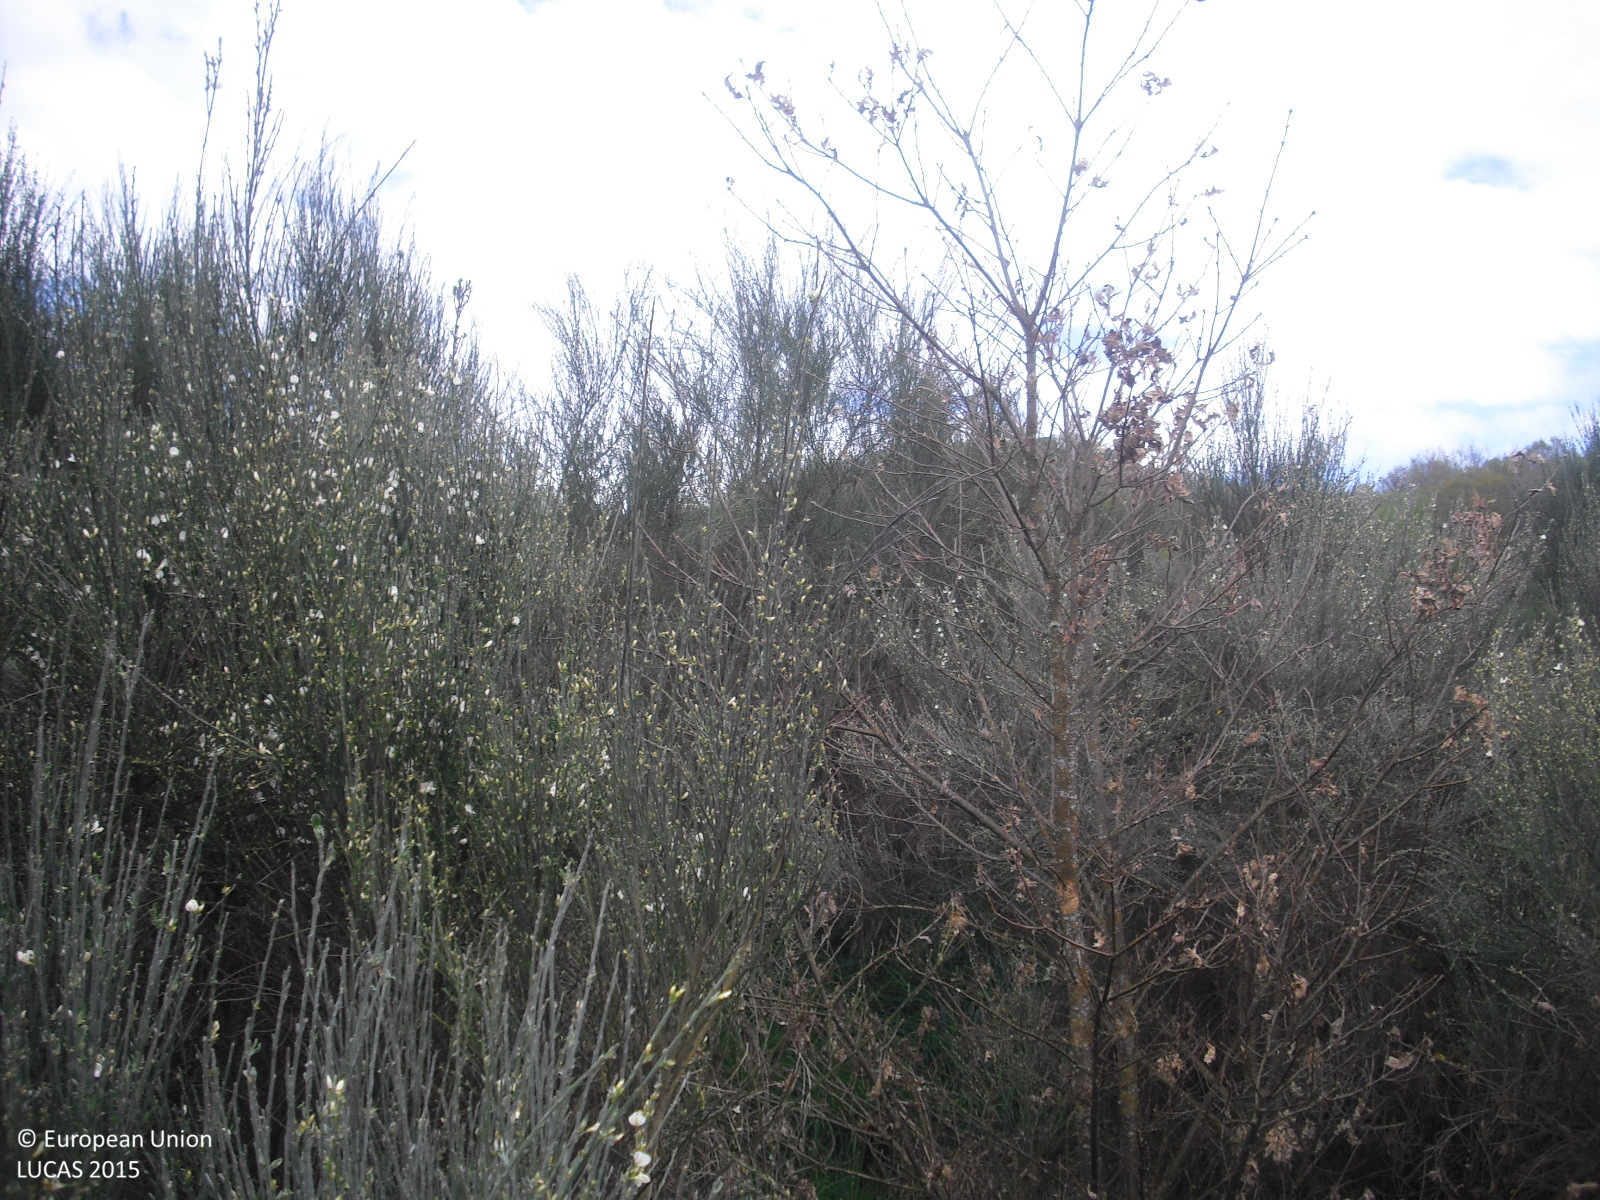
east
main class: Shrubland
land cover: Shrubland with sparse tree cover
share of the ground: > 75 %
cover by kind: shrubs 85 %, herbaceous plants 10 %, broadleaved forest trees 5 %
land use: Abandoned areas
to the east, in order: Shrubland with sparse tree cover; Shrubland without tree cover; Ditches and canals; Tracks; Ditches and canals; Shrubland without tree cover; Ditches and canals; Tracks; Ditches and canals; Fences; Shruby margins; Grassland without tree/shrub cover; Ditches and canals; Grassland without tree/shrub cover; Ditches and canals; Grassland without tree/shrub cover; Ditches and canals; Grassland without tree/shrub cover; Ditches and canals; Fences; Dry stone walls; Broadleaved woodland
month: April
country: ES
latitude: 41.9543
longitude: -7.8665
